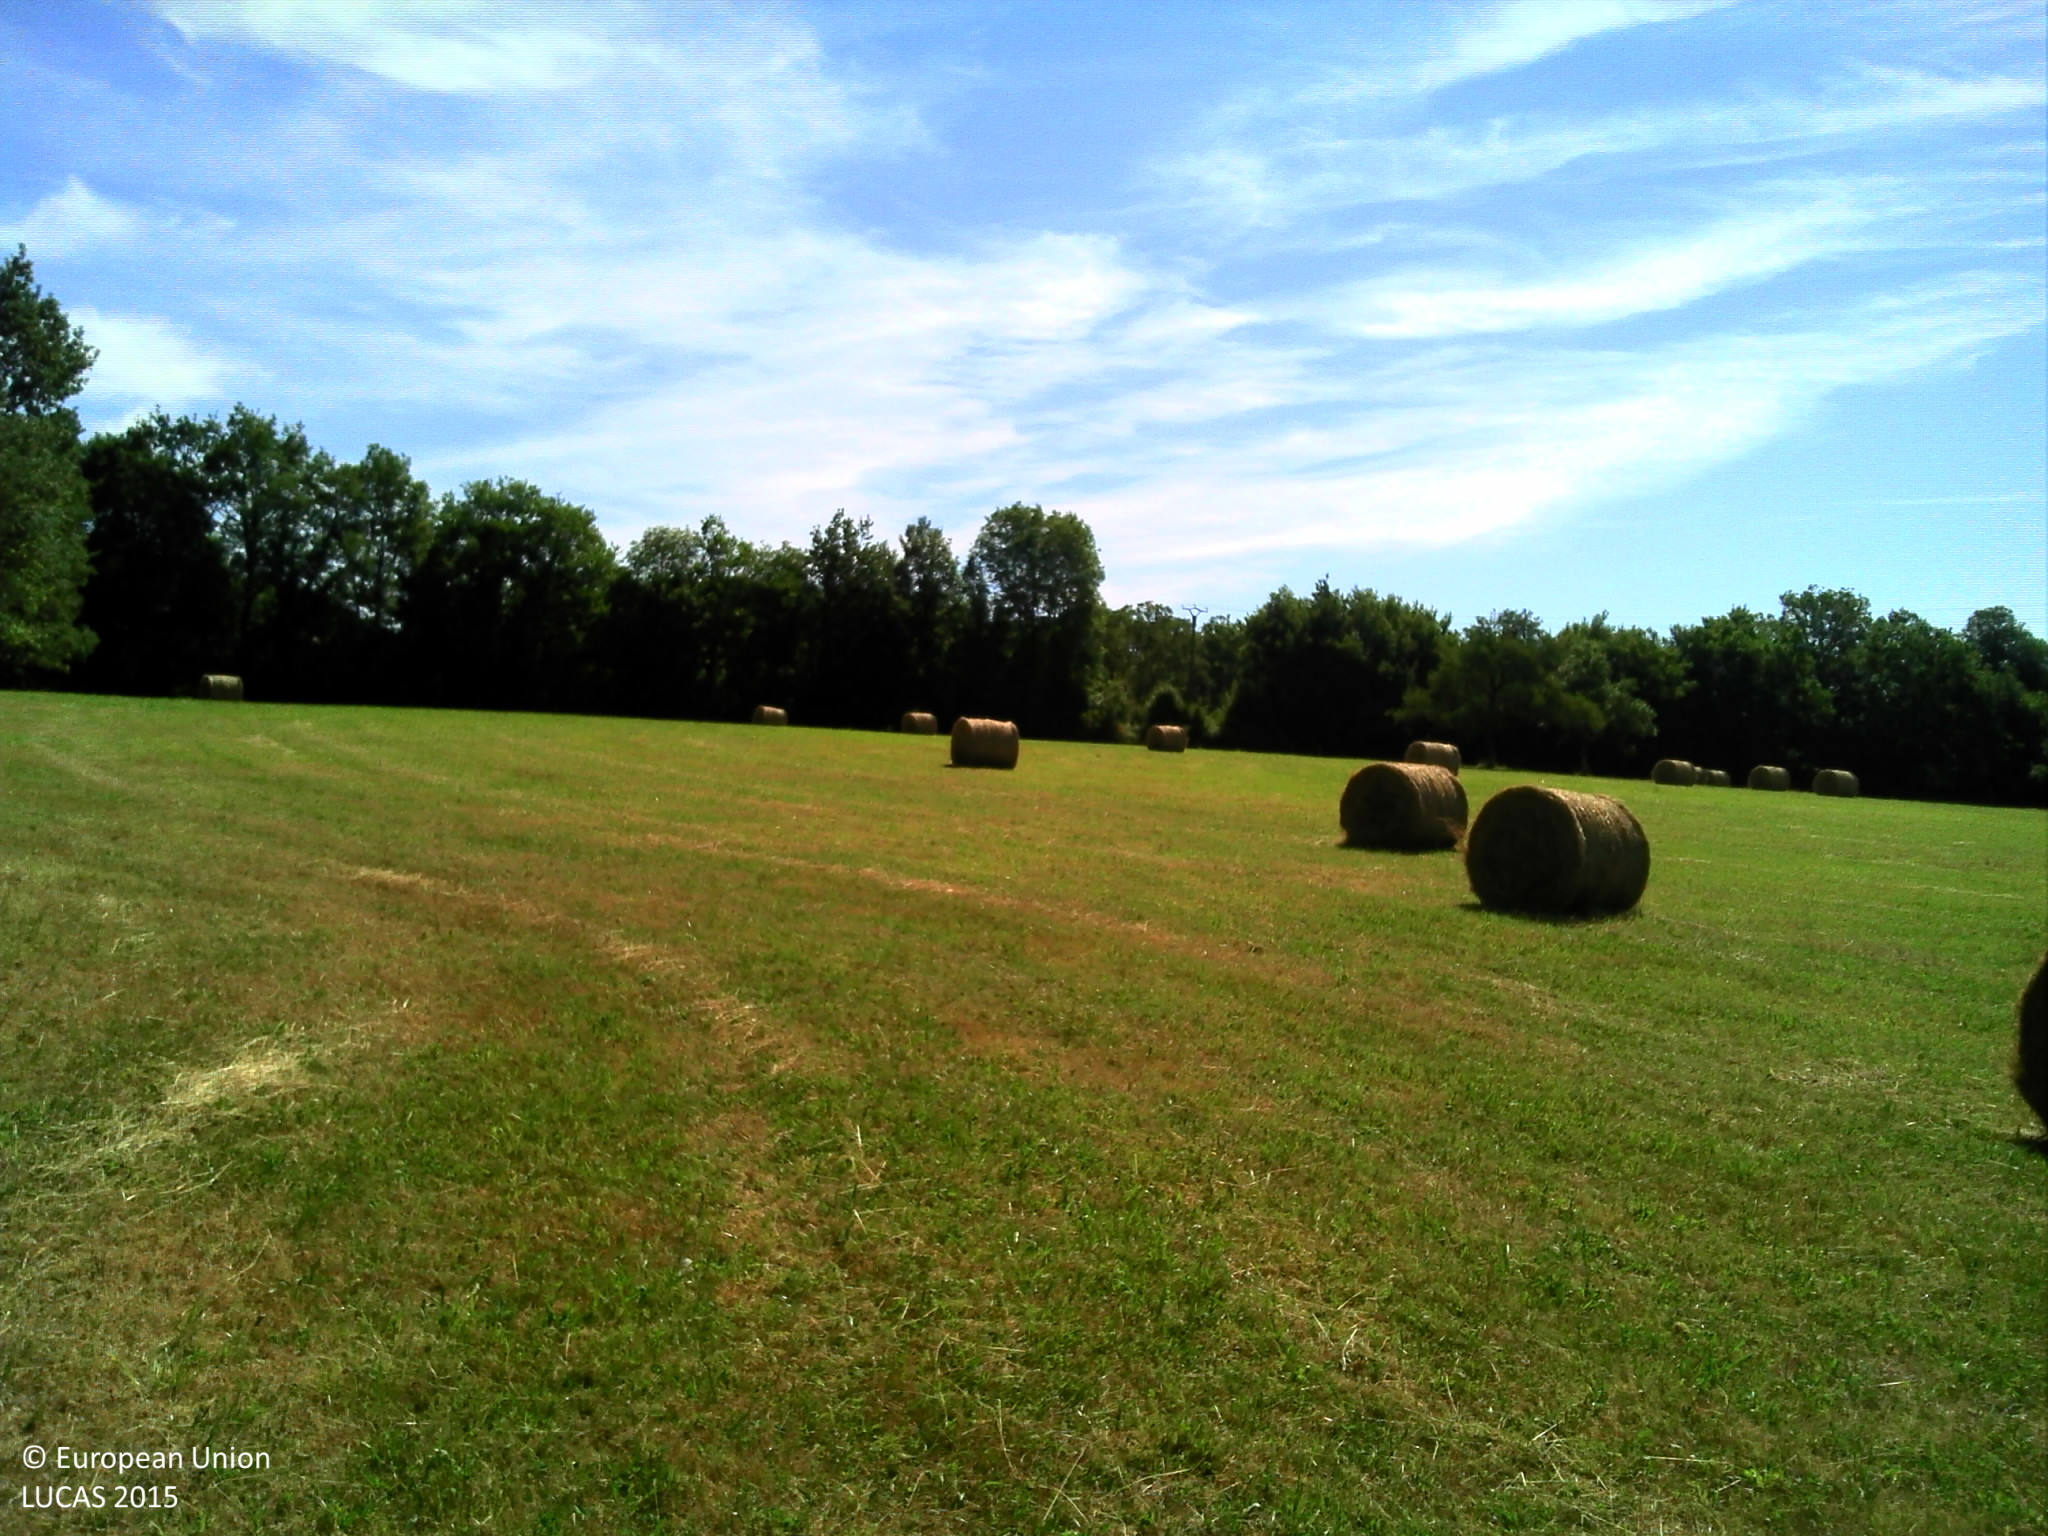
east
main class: Grassland
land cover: Grassland without tree/shrub cover
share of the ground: > 75 %
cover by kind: herbaceous plants 100 %
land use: Agriculture (excluding fallow land and kitchen gardens)
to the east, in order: Grassland without tree/shrub cover; Electric lines; Spontaneously vegetated surfaces; Grassland without tree/shrub cover; Broadleaved woodland; Grassland without tree/shrub cover; Broadleaved woodland; Grassland without tree/shrub cover; Broadleaved woodland; Dry stone walls; Broadleaved woodland
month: June
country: FR
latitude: 44.7504
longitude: 1.8009
